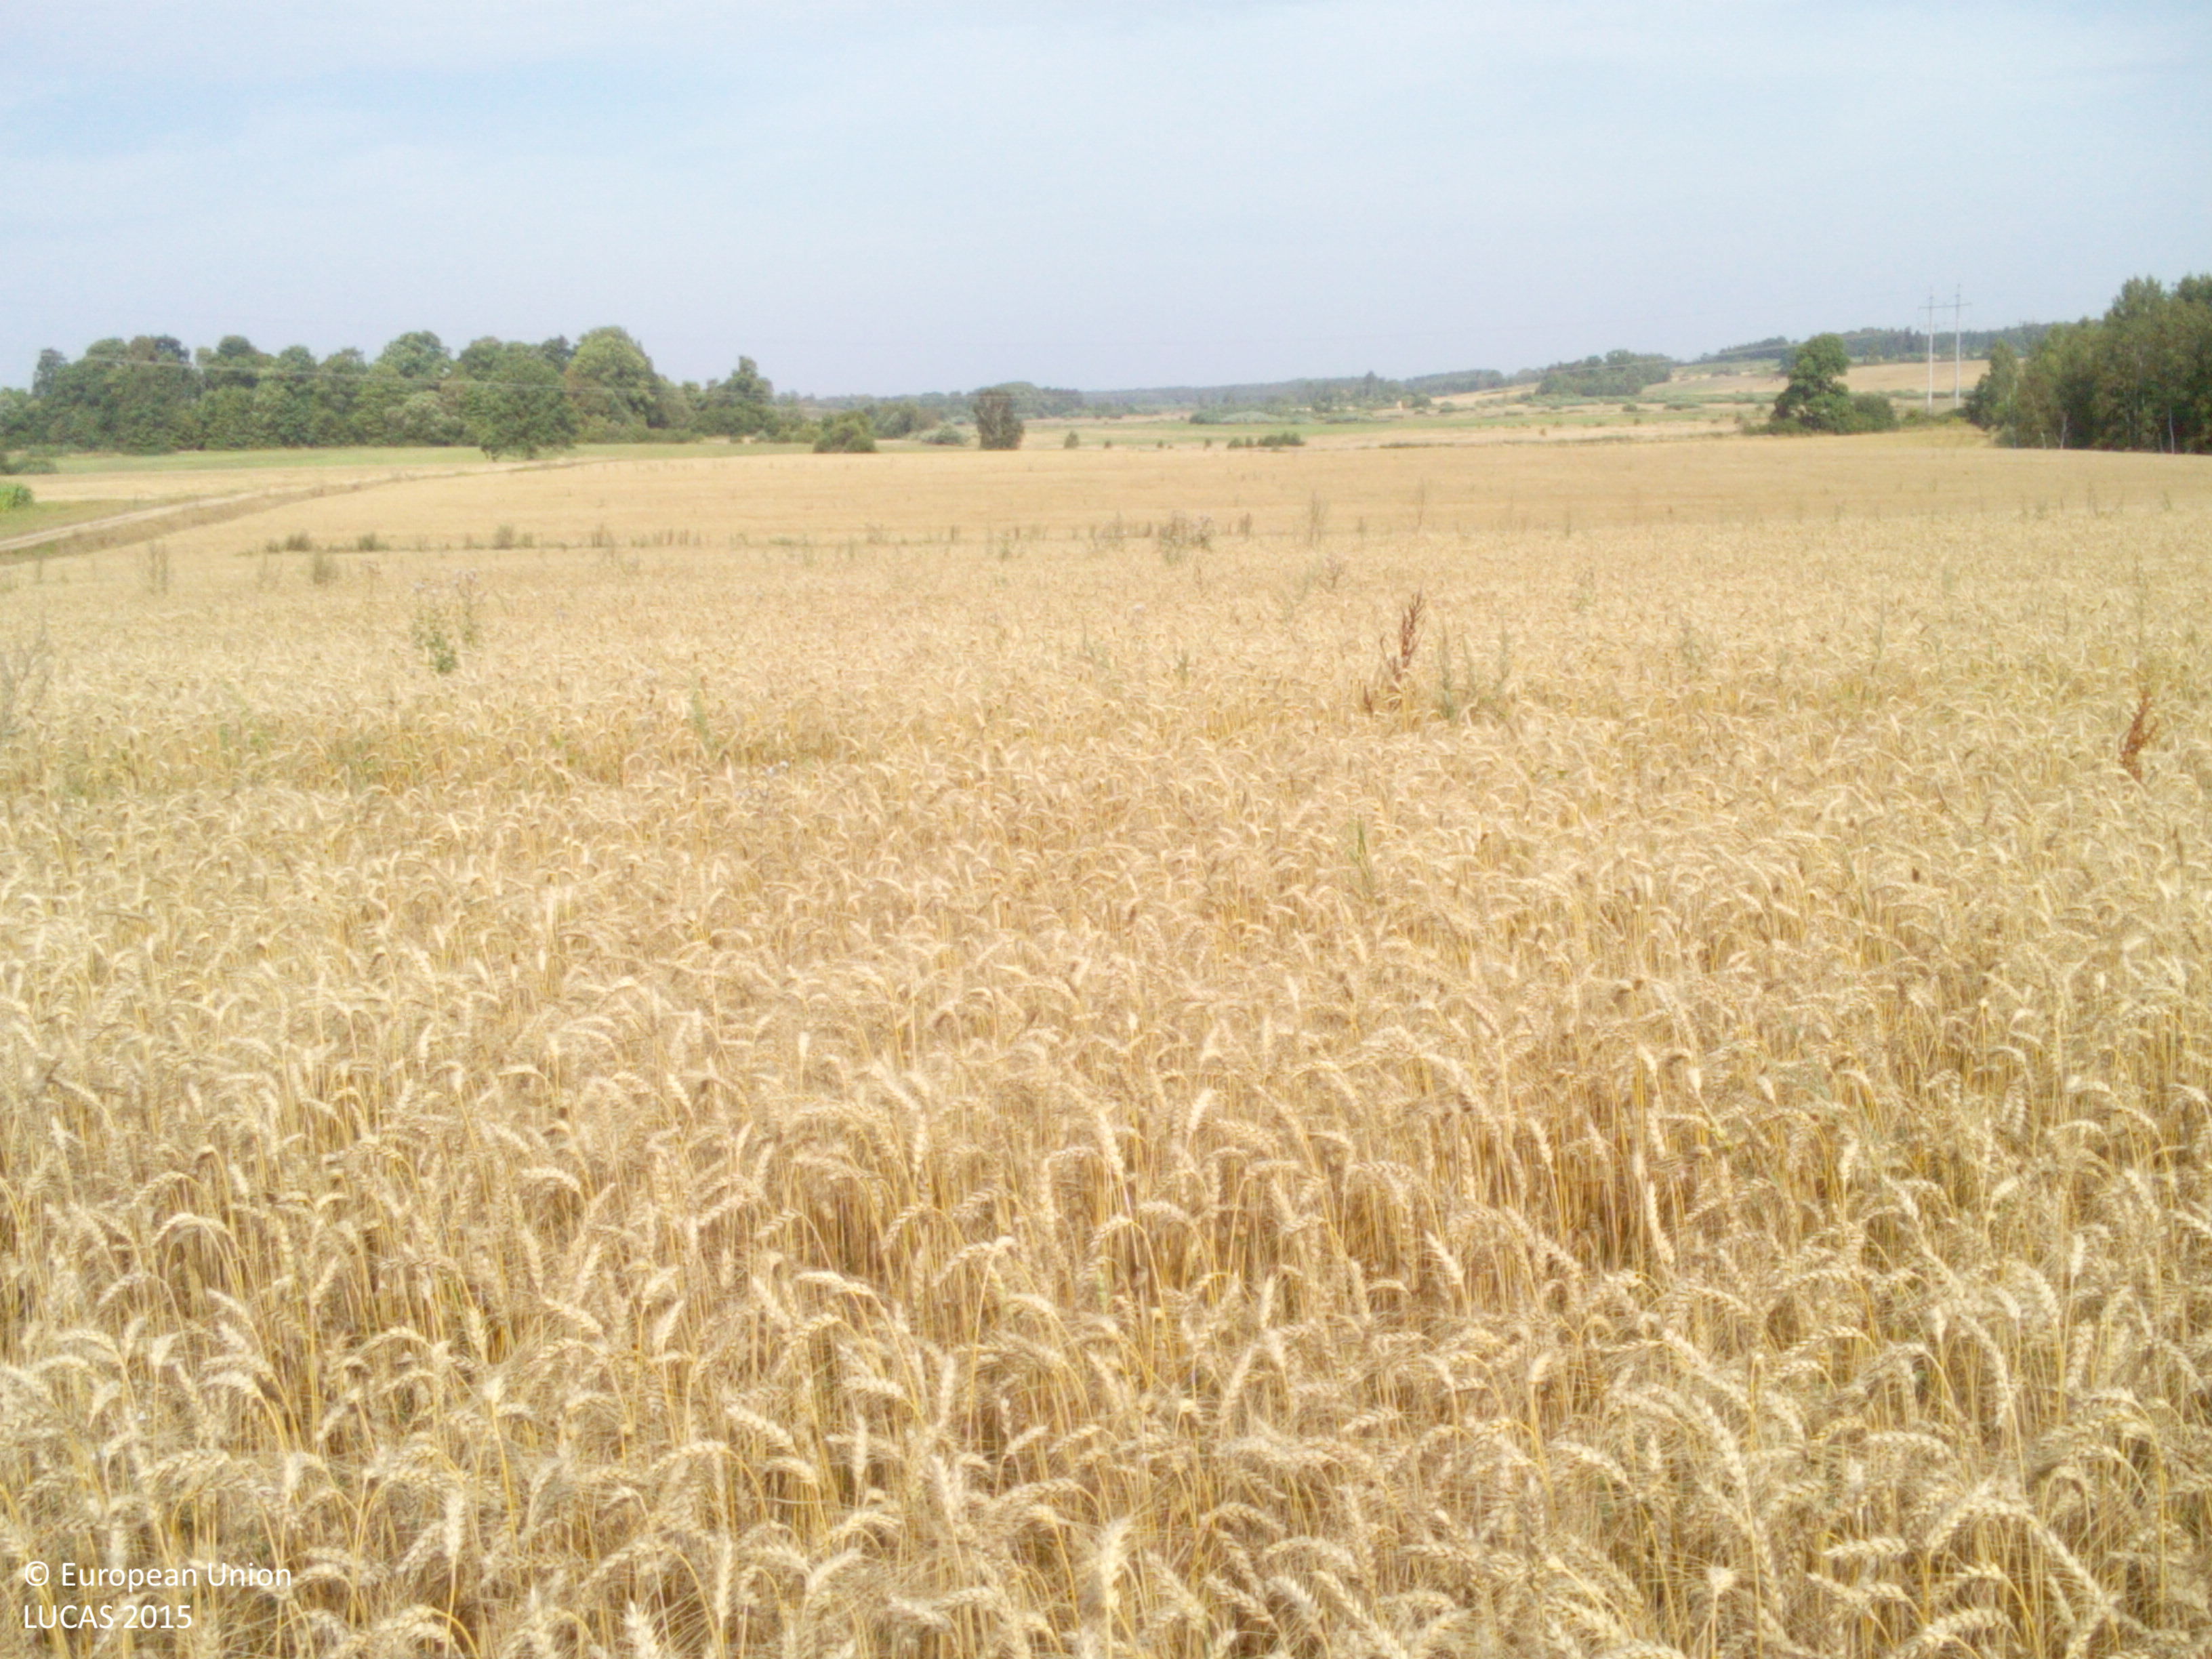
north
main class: Cropland
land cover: Common wheat
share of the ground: > 75 %
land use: Agriculture (excluding fallow land and kitchen gardens)
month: August
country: LV
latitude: 56.1803
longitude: 21.2690
